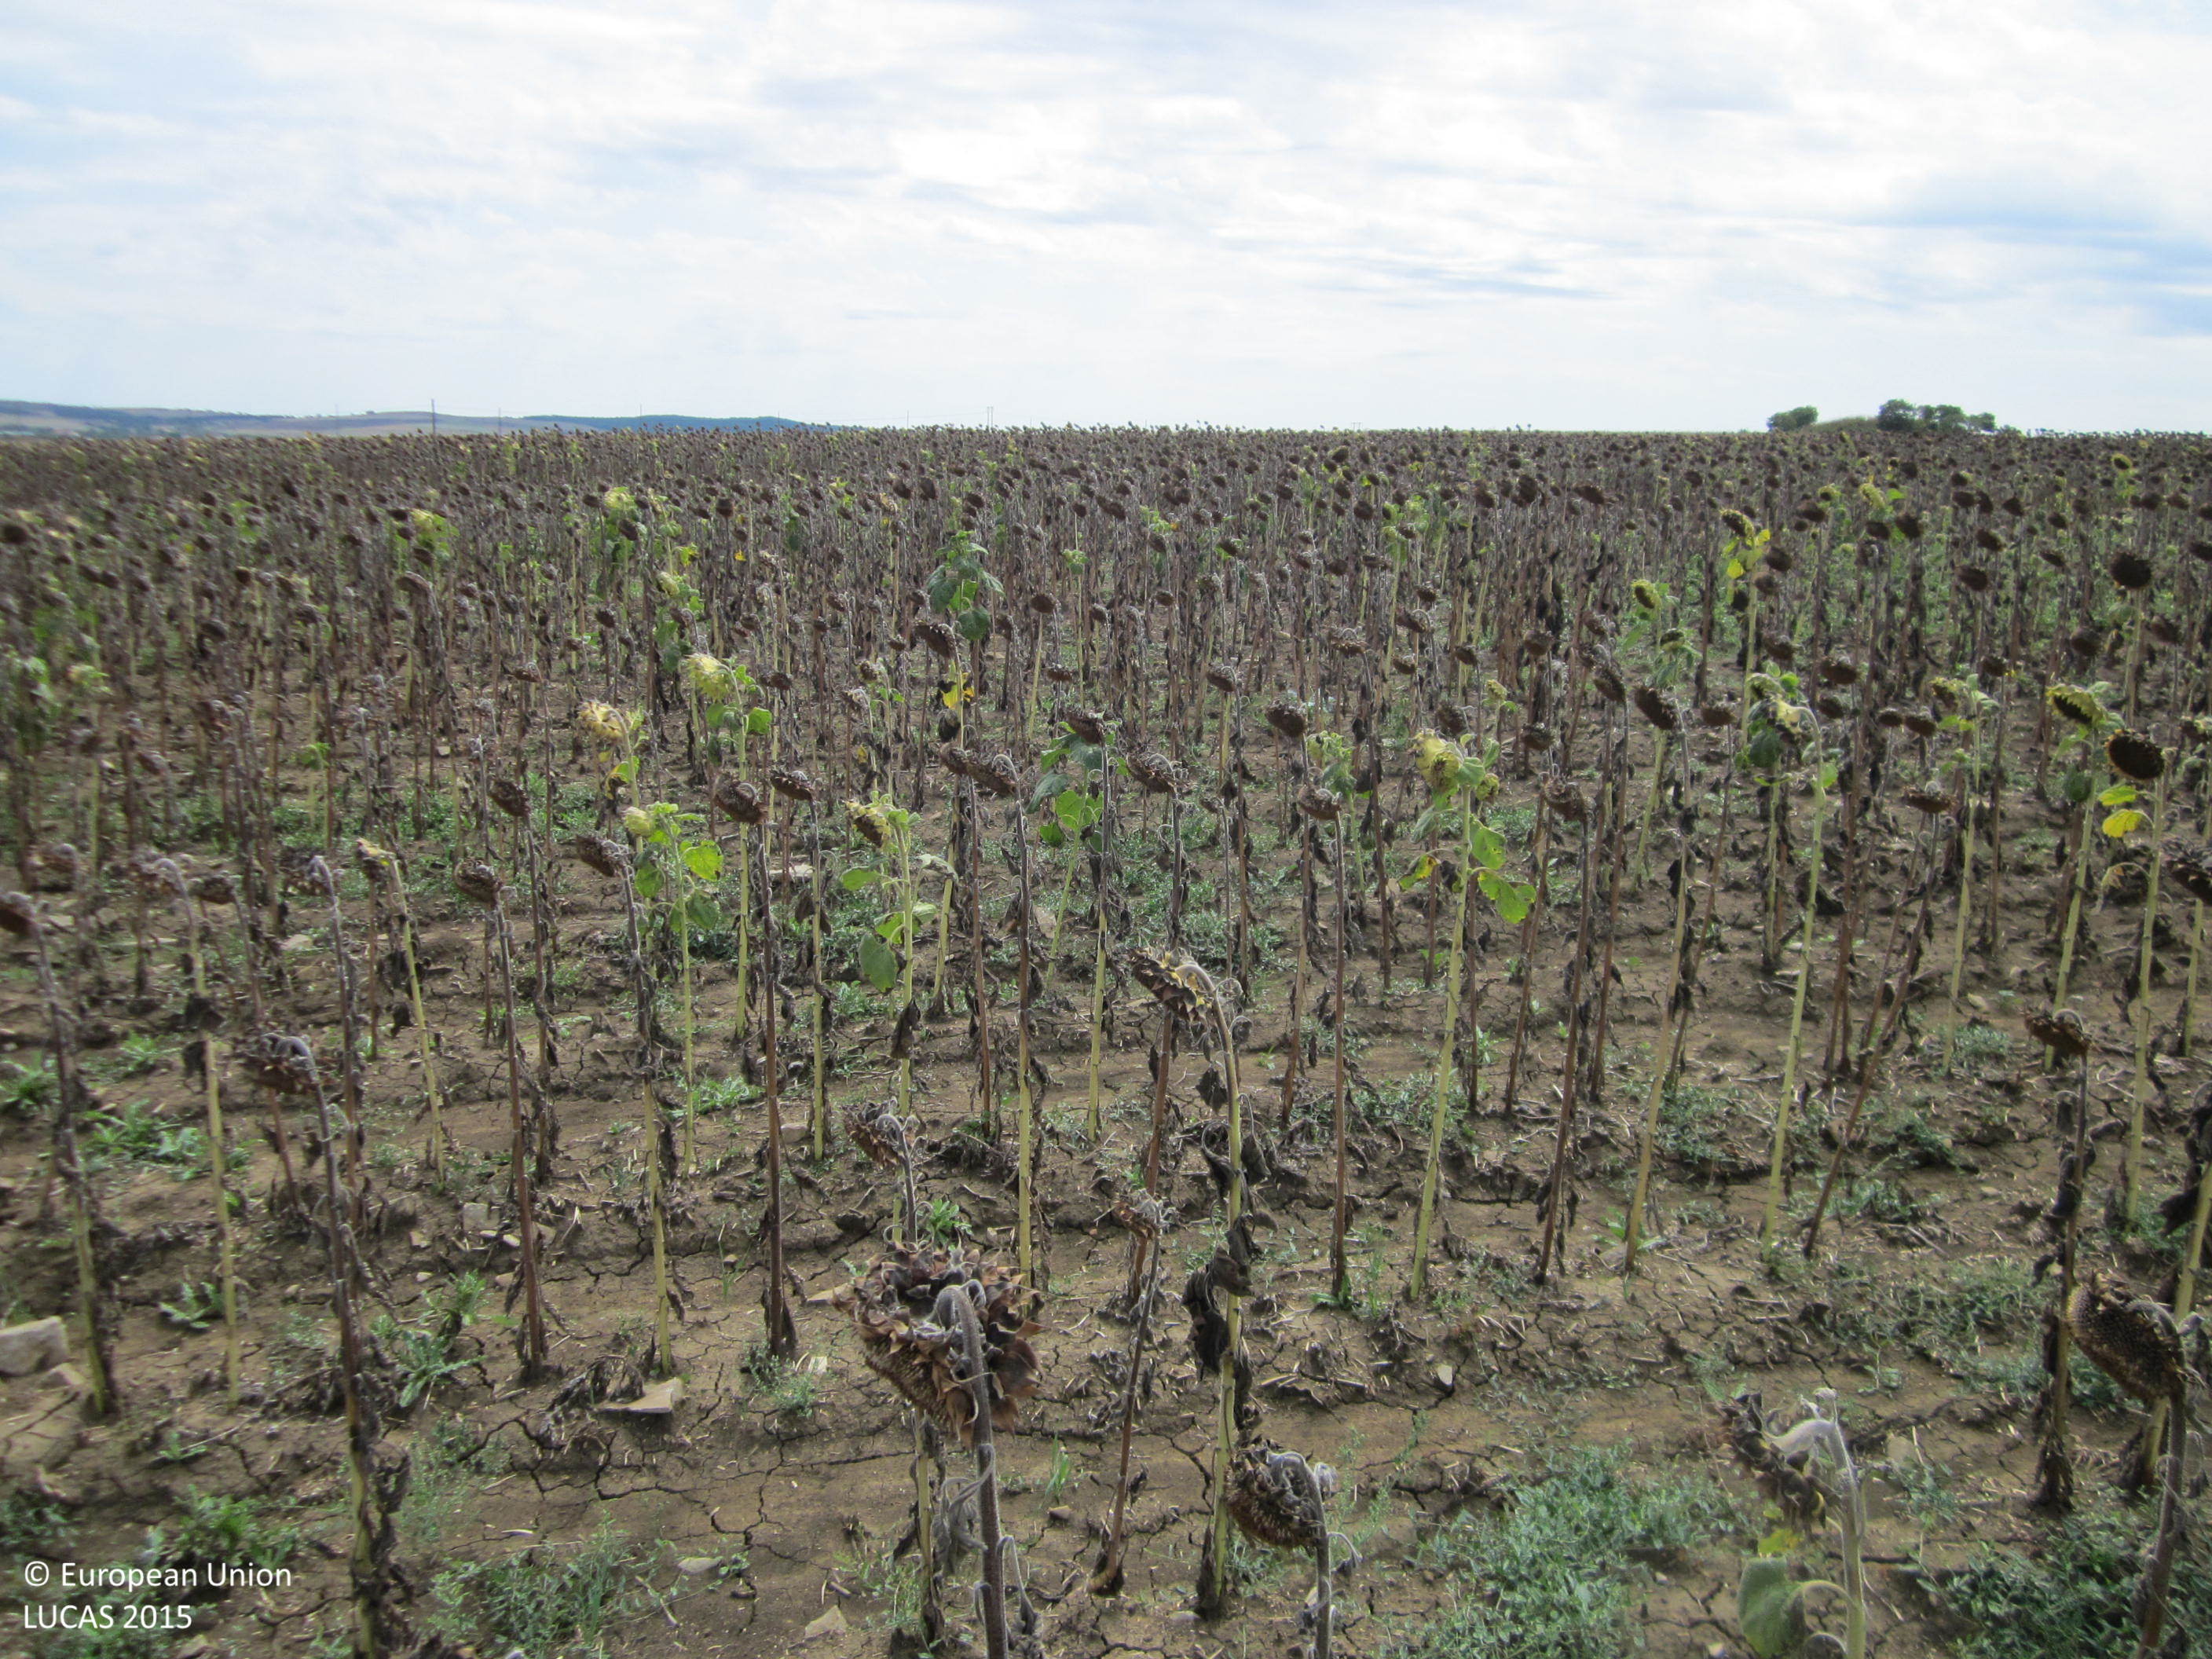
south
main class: Cropland
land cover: Sunflower
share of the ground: 50 - 75 %
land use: Agriculture (excluding fallow land and kitchen gardens)
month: September
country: BG
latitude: 42.6896
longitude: 27.0371
